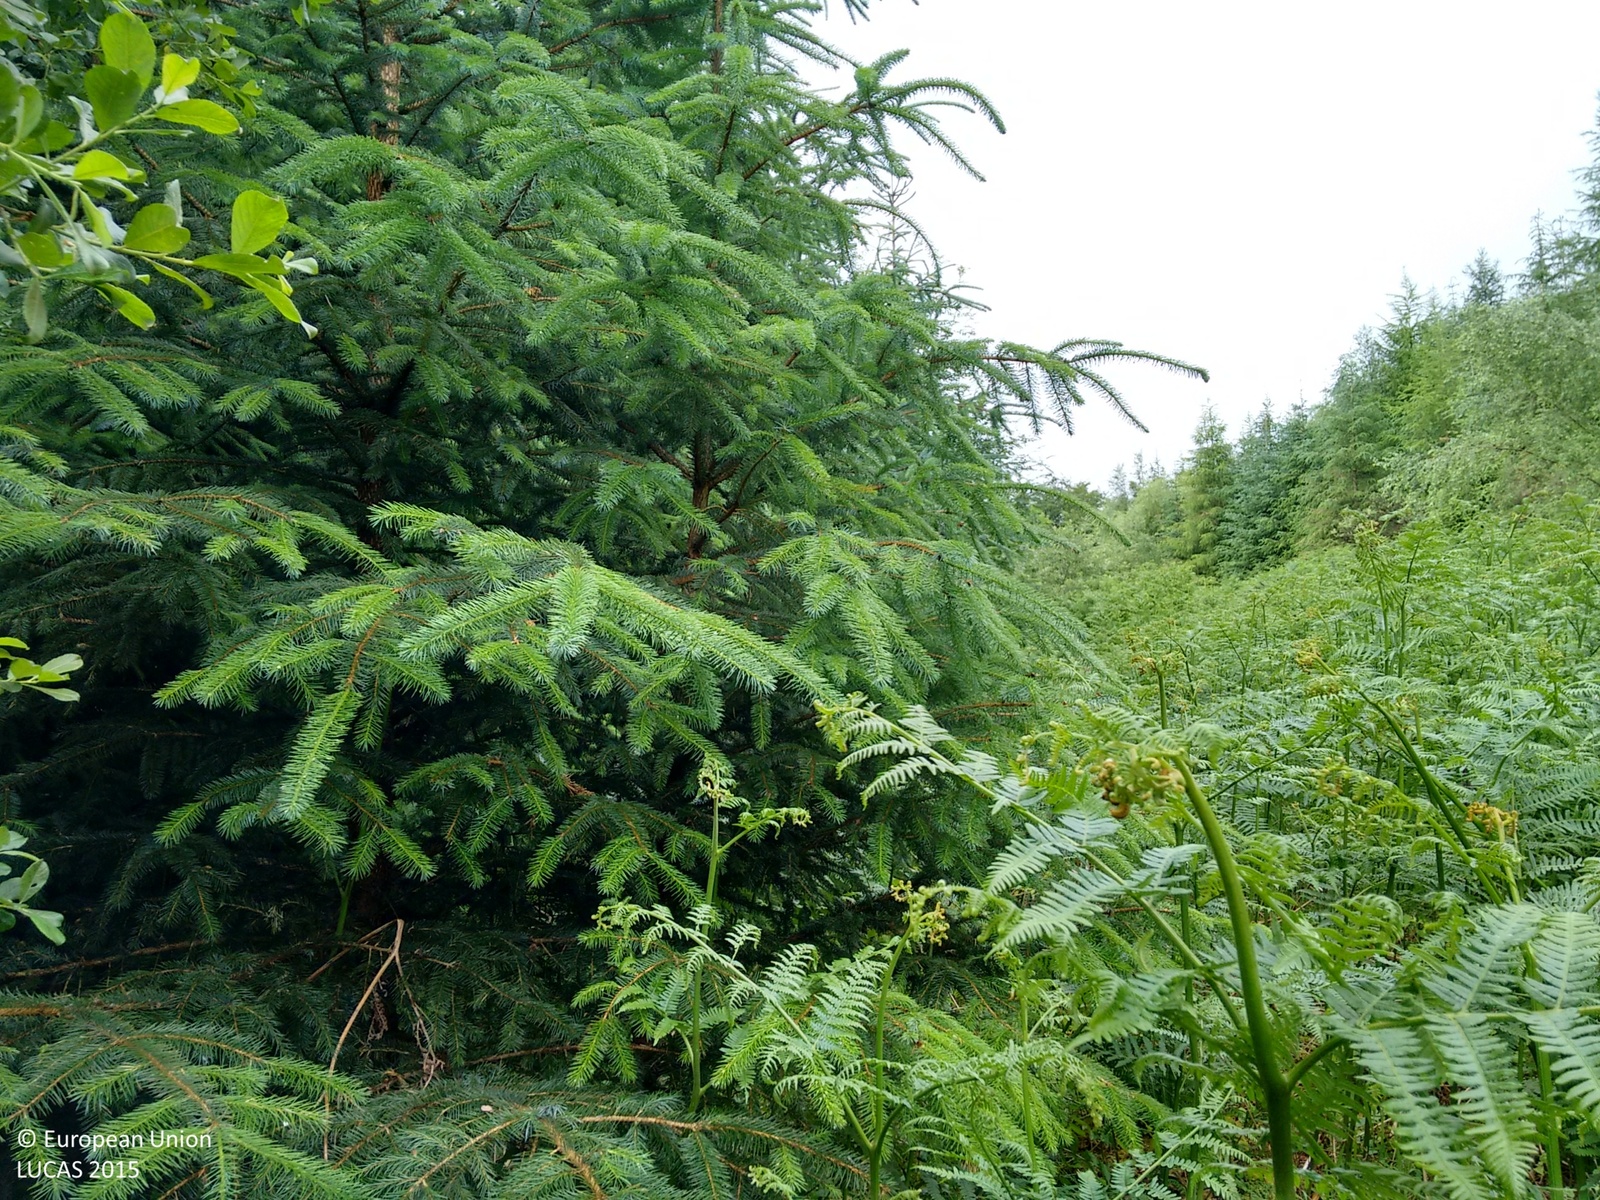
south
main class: Woodland
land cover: Other mixed woodland
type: exotic forest
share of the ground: > 75 %
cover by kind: coniferous forest trees 75 %, broadleaved forest trees 25 %
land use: Forestry
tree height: > 5 m
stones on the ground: > 50 %
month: July
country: GB
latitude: 54.9986
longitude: -3.6366
